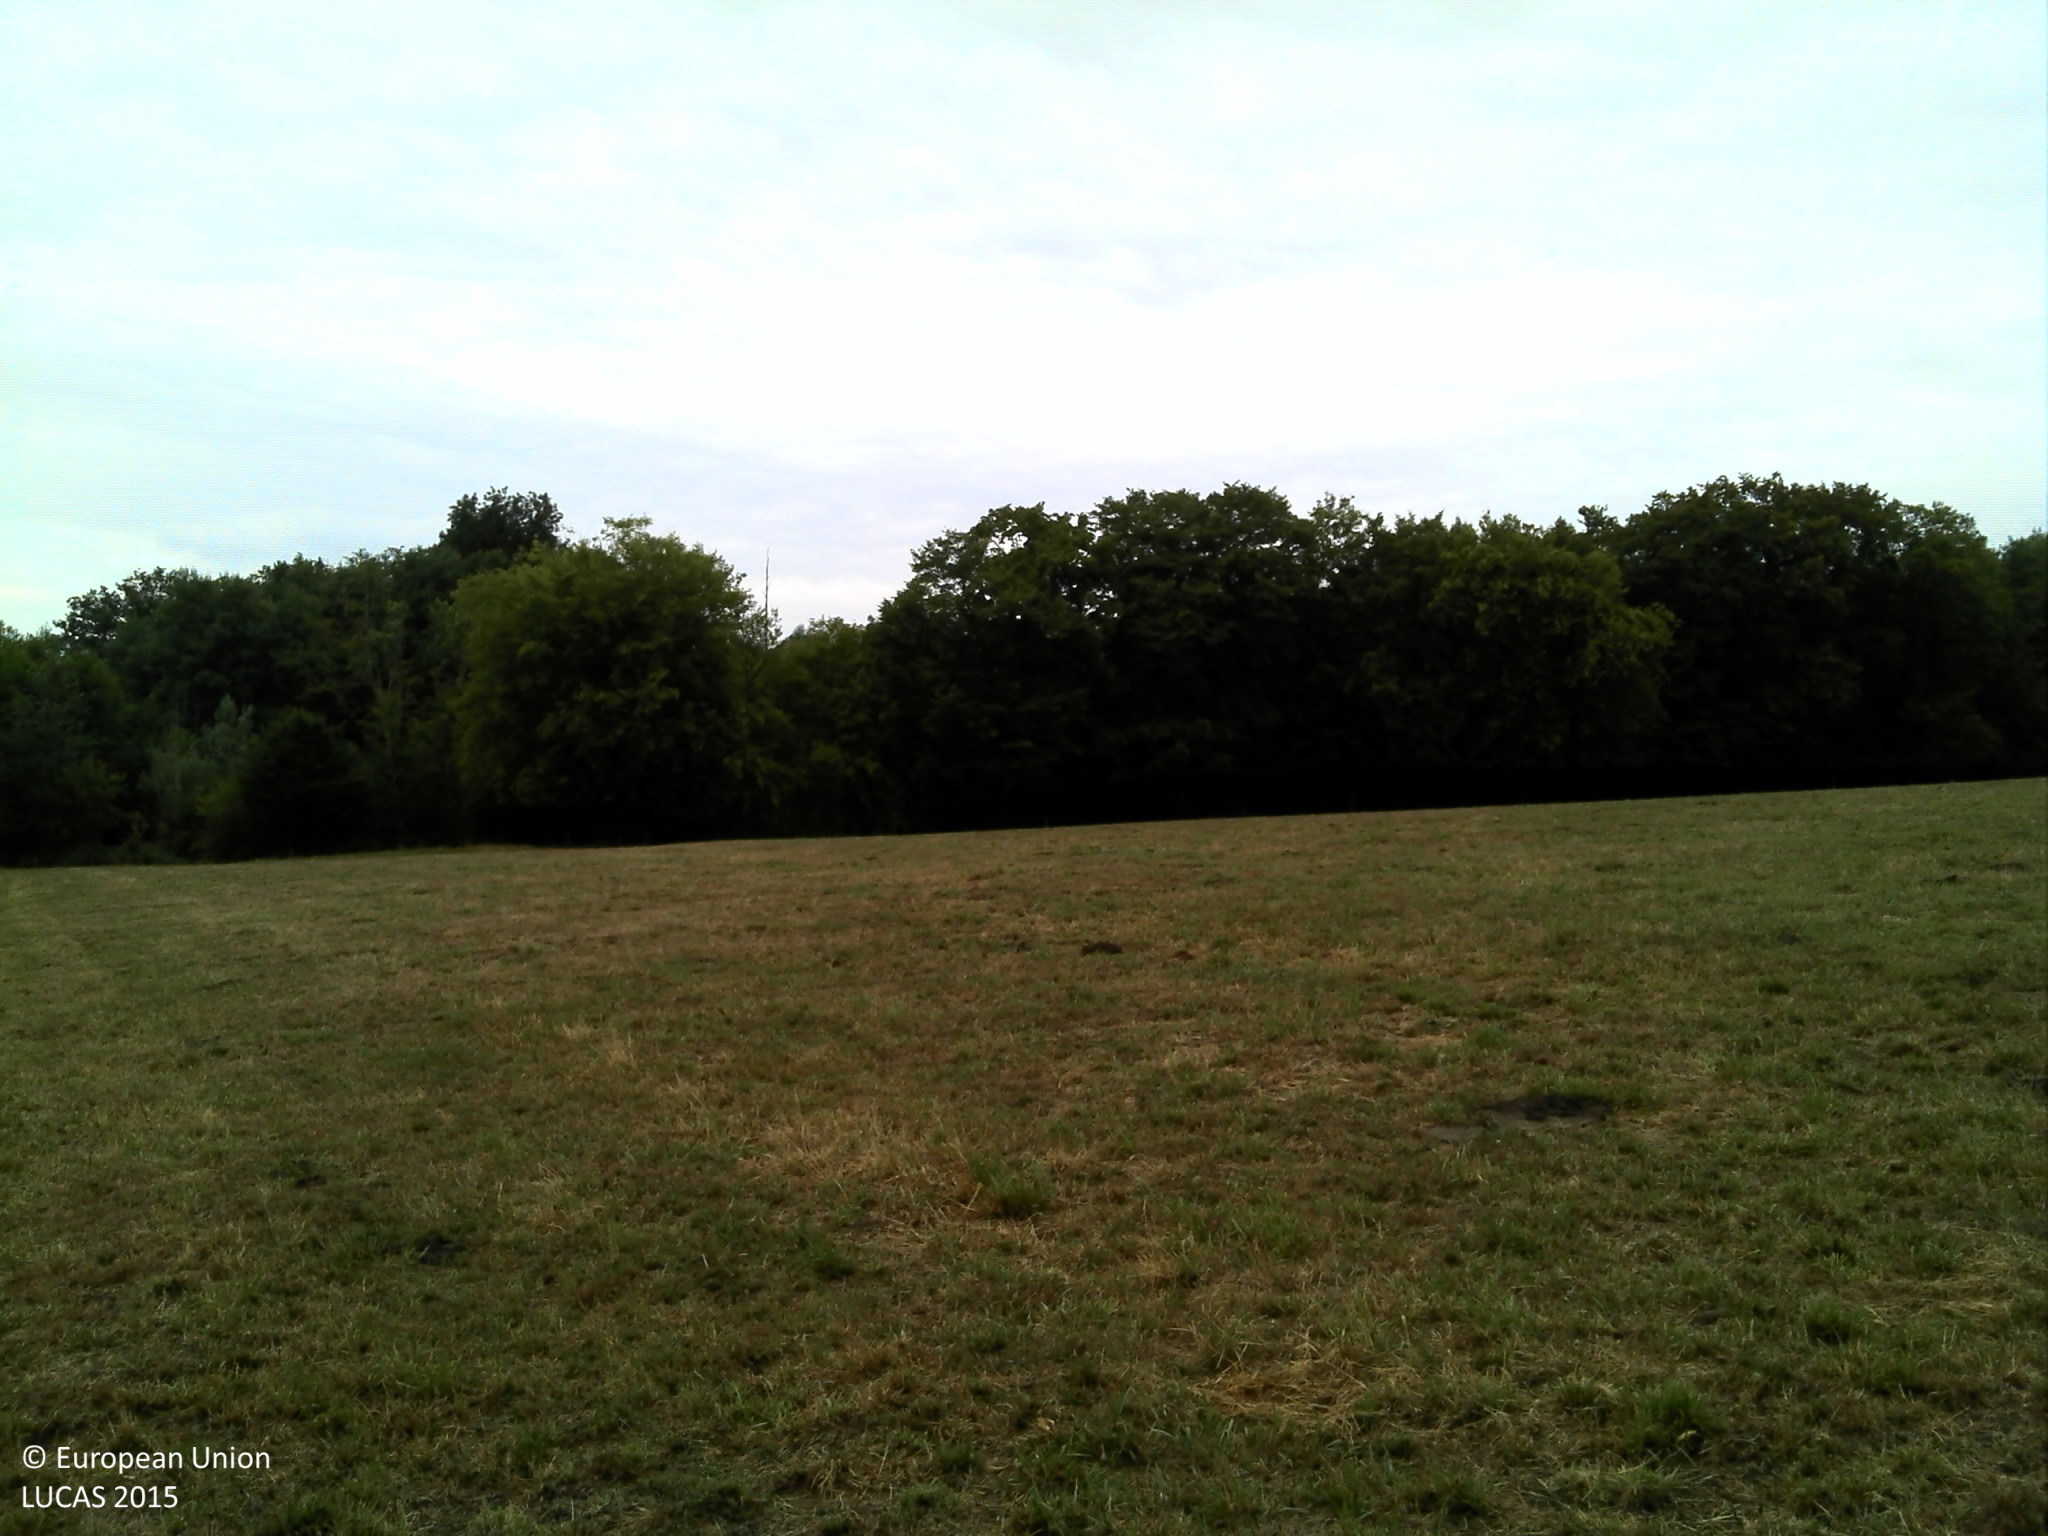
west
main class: Grassland
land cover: Grassland without tree/shrub cover
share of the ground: > 75 %
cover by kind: herbaceous plants 100 %
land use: Agriculture (excluding fallow land and kitchen gardens)
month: August
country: FR
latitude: 46.1485
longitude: 4.0326
